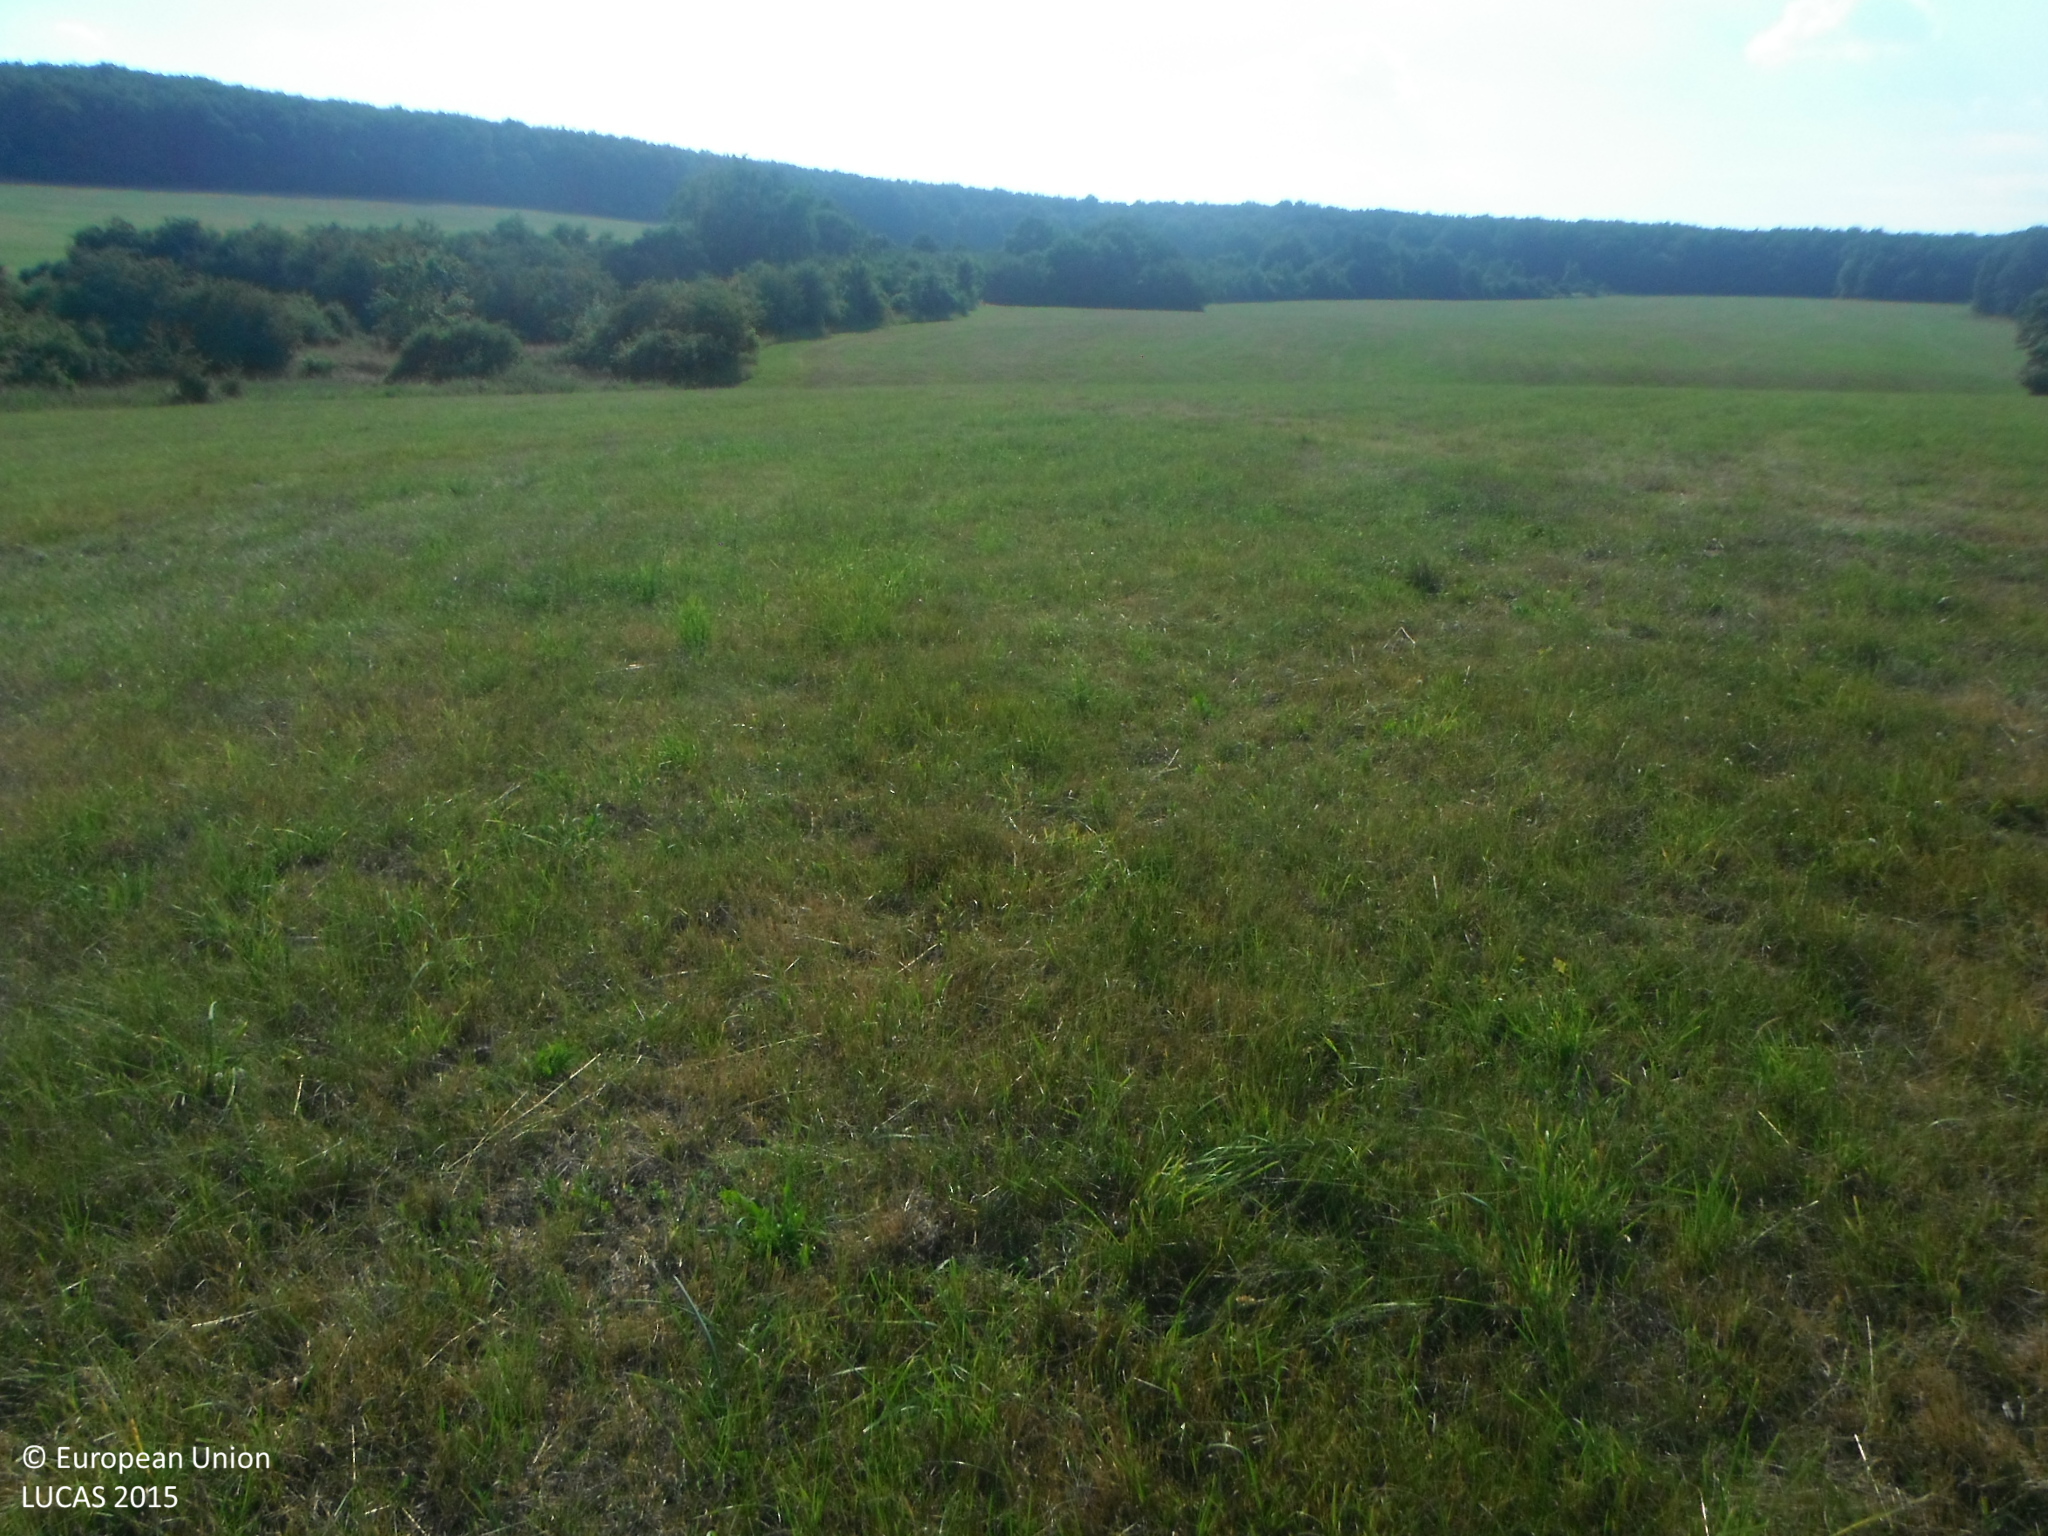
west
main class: Grassland
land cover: Grassland without tree/shrub cover
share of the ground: > 75 %
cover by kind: herbaceous plants 100 %
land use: Agriculture (excluding fallow land and kitchen gardens)
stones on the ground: < 10 %
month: July
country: SK
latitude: 48.4228
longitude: 18.2172
